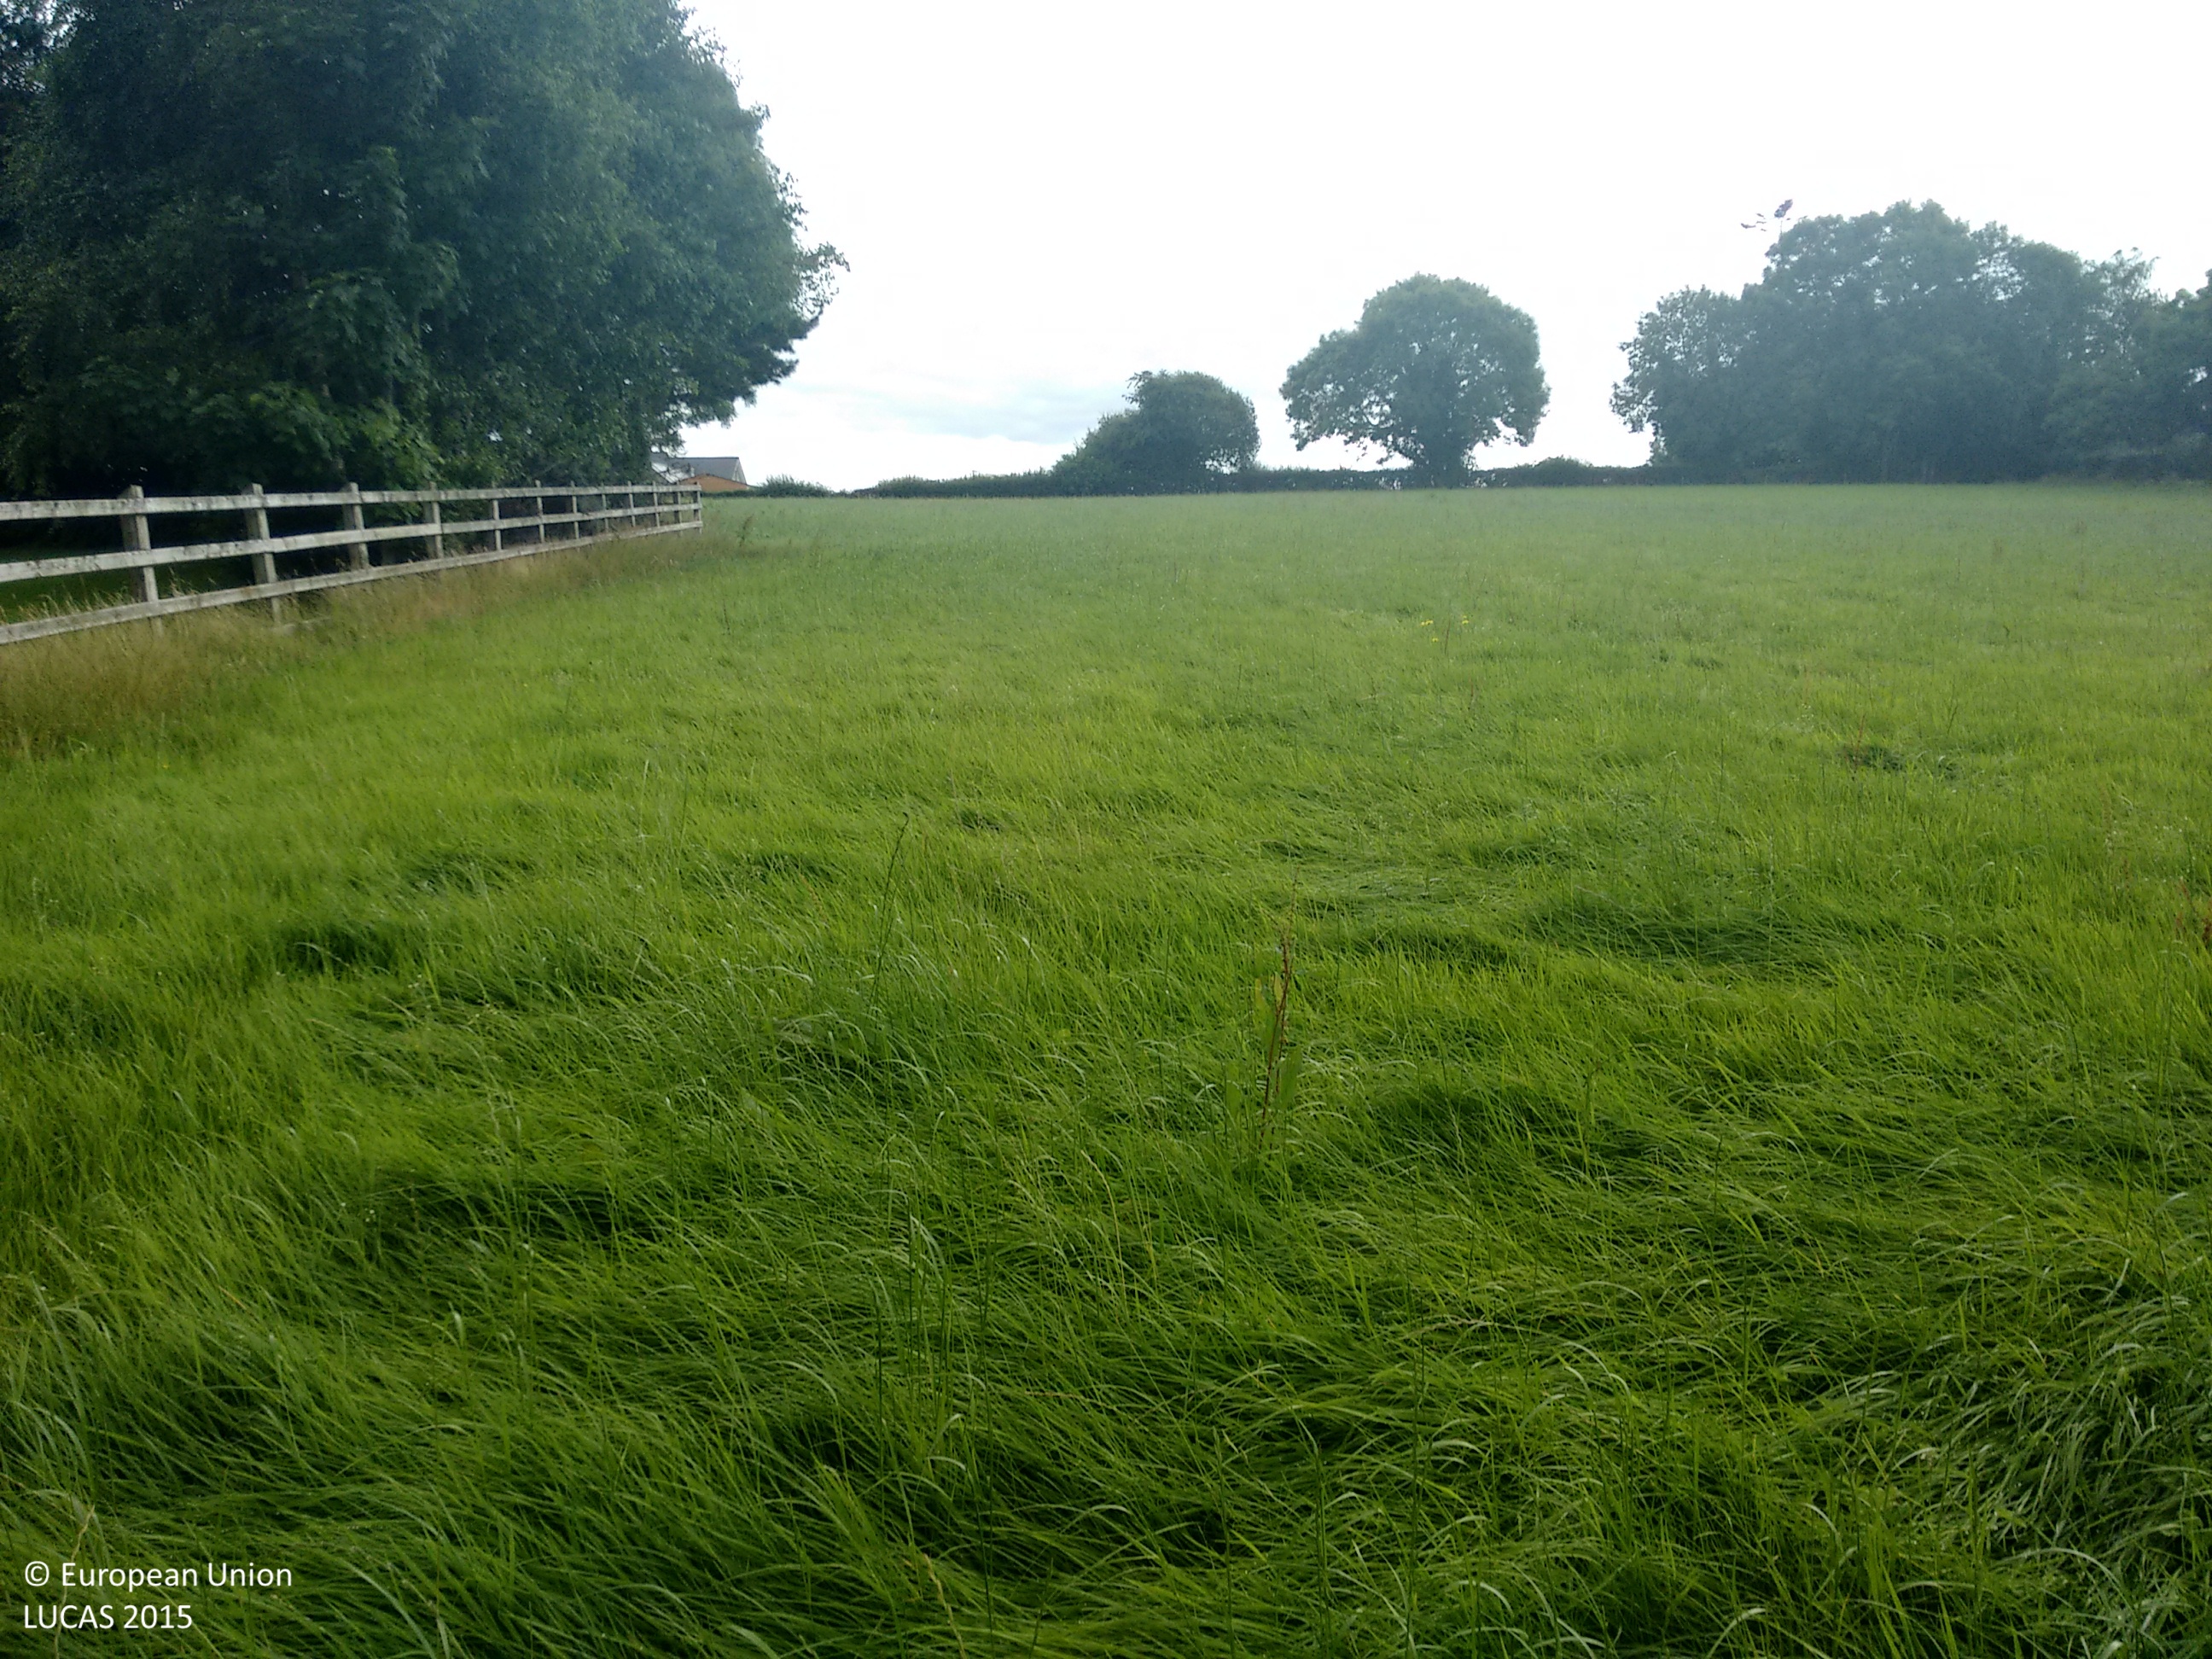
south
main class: Grassland
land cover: Grassland without tree/shrub cover
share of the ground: > 75 %
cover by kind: herbaceous plants 100 %
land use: Agriculture (excluding fallow land and kitchen gardens)
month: August
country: GB
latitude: 54.3280
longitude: -6.6914
